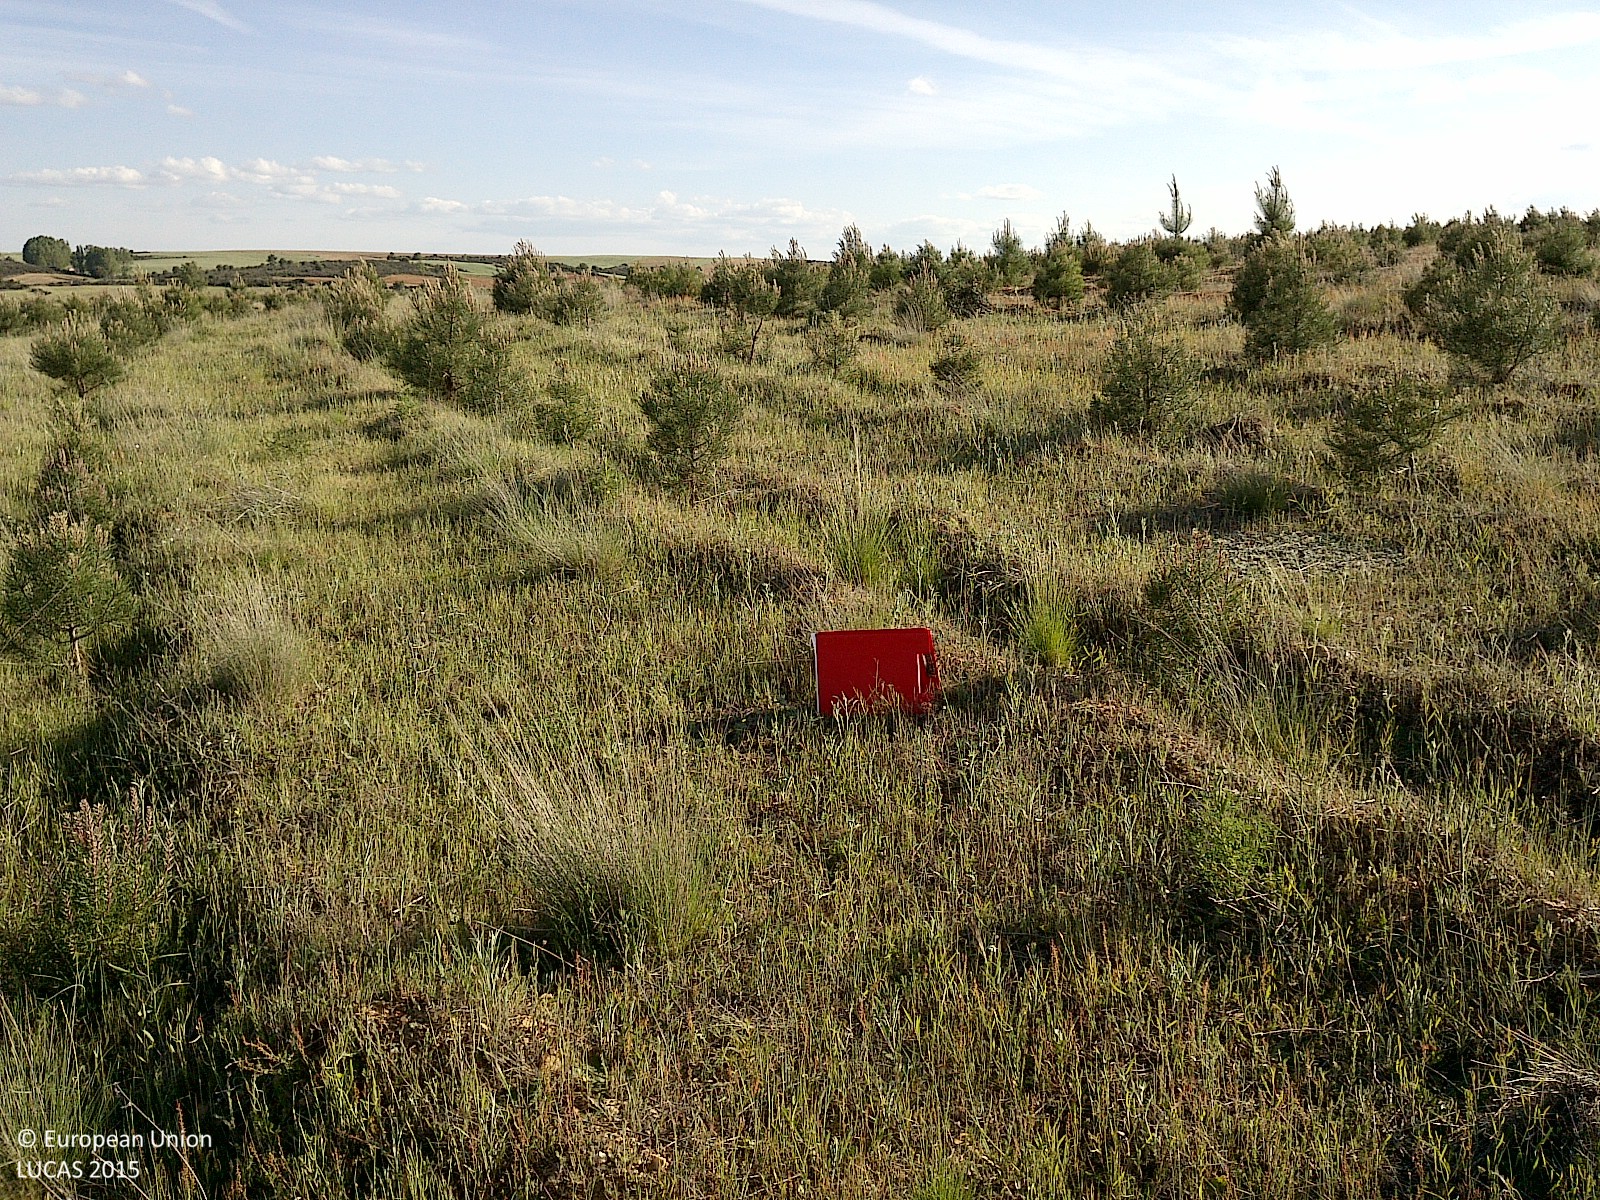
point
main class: Grassland
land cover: Grassland with sparse tree/shrub cover
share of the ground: > 75 %
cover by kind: herbaceous plants 95 %, coniferous forest trees 5 %
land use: Forestry
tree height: < 5 m
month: May
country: ES
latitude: 41.7213
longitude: -3.1360
